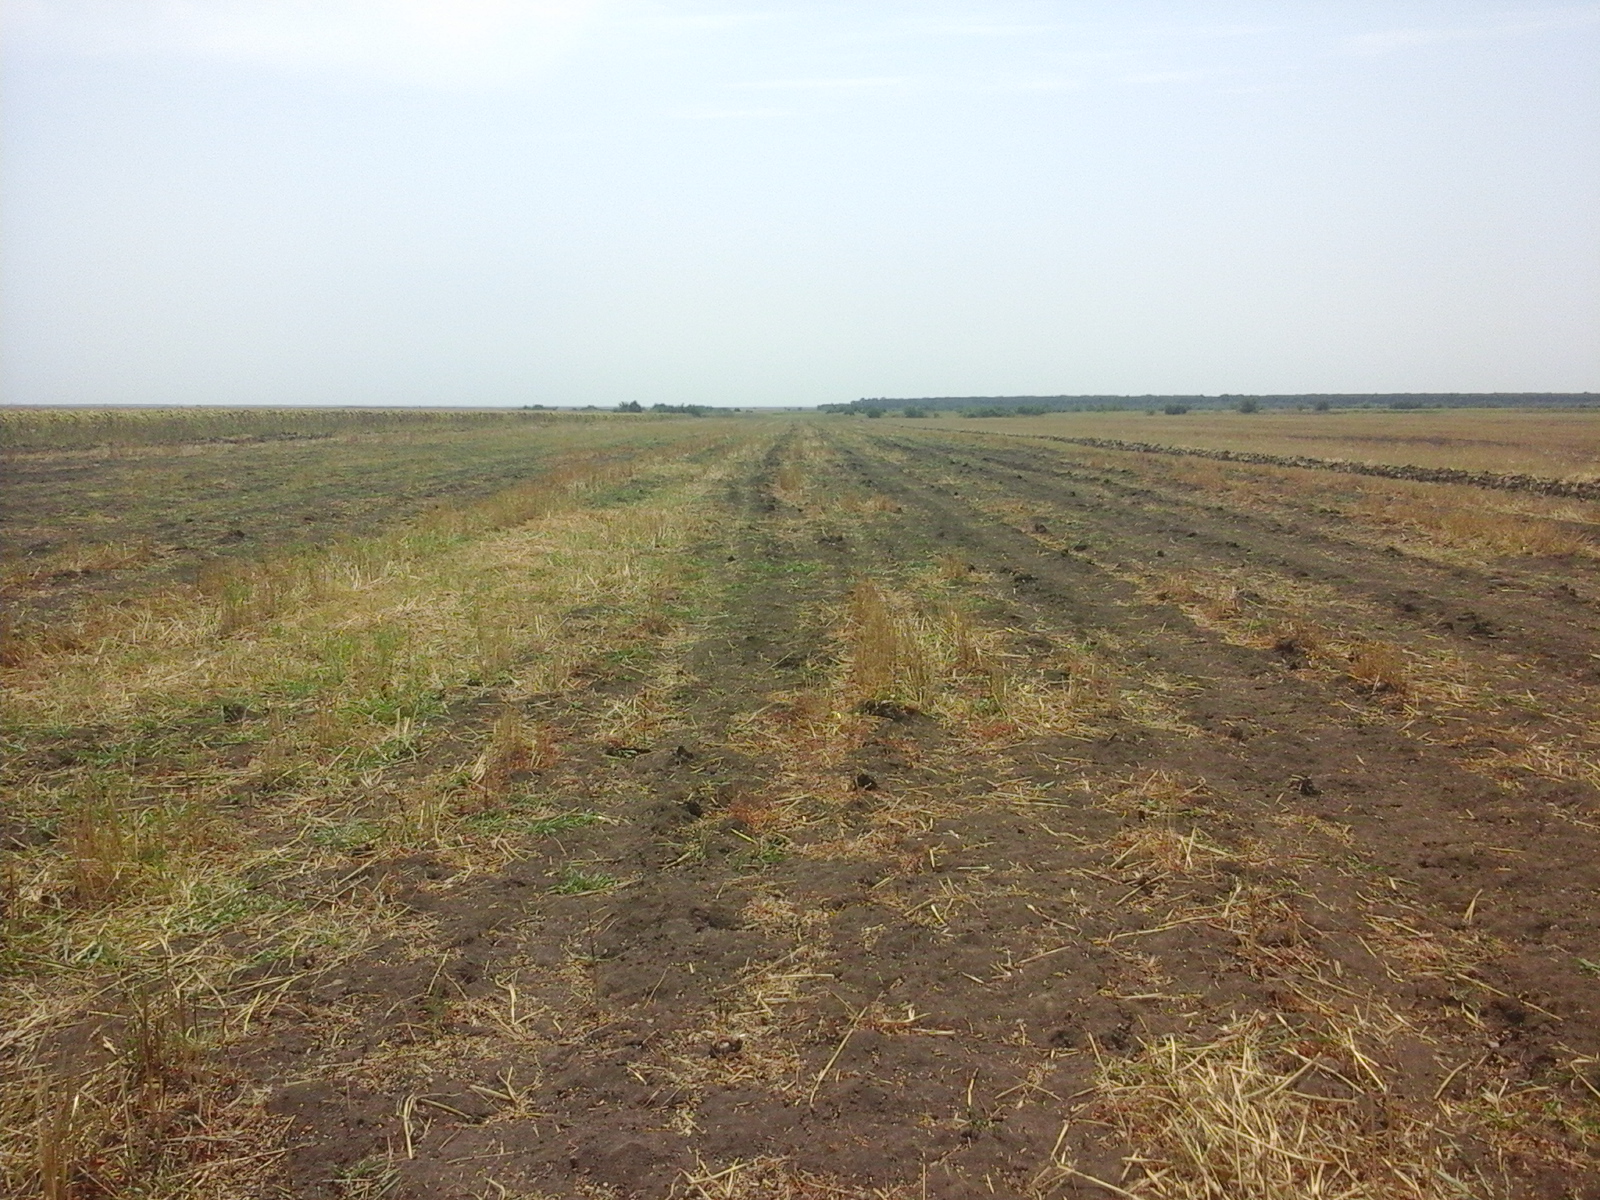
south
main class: Cropland
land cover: Common wheat
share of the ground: 25 - 50 %
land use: Agriculture (excluding fallow land and kitchen gardens)
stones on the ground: < 10 %
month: August
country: RO
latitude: 44.0941
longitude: 23.7055
